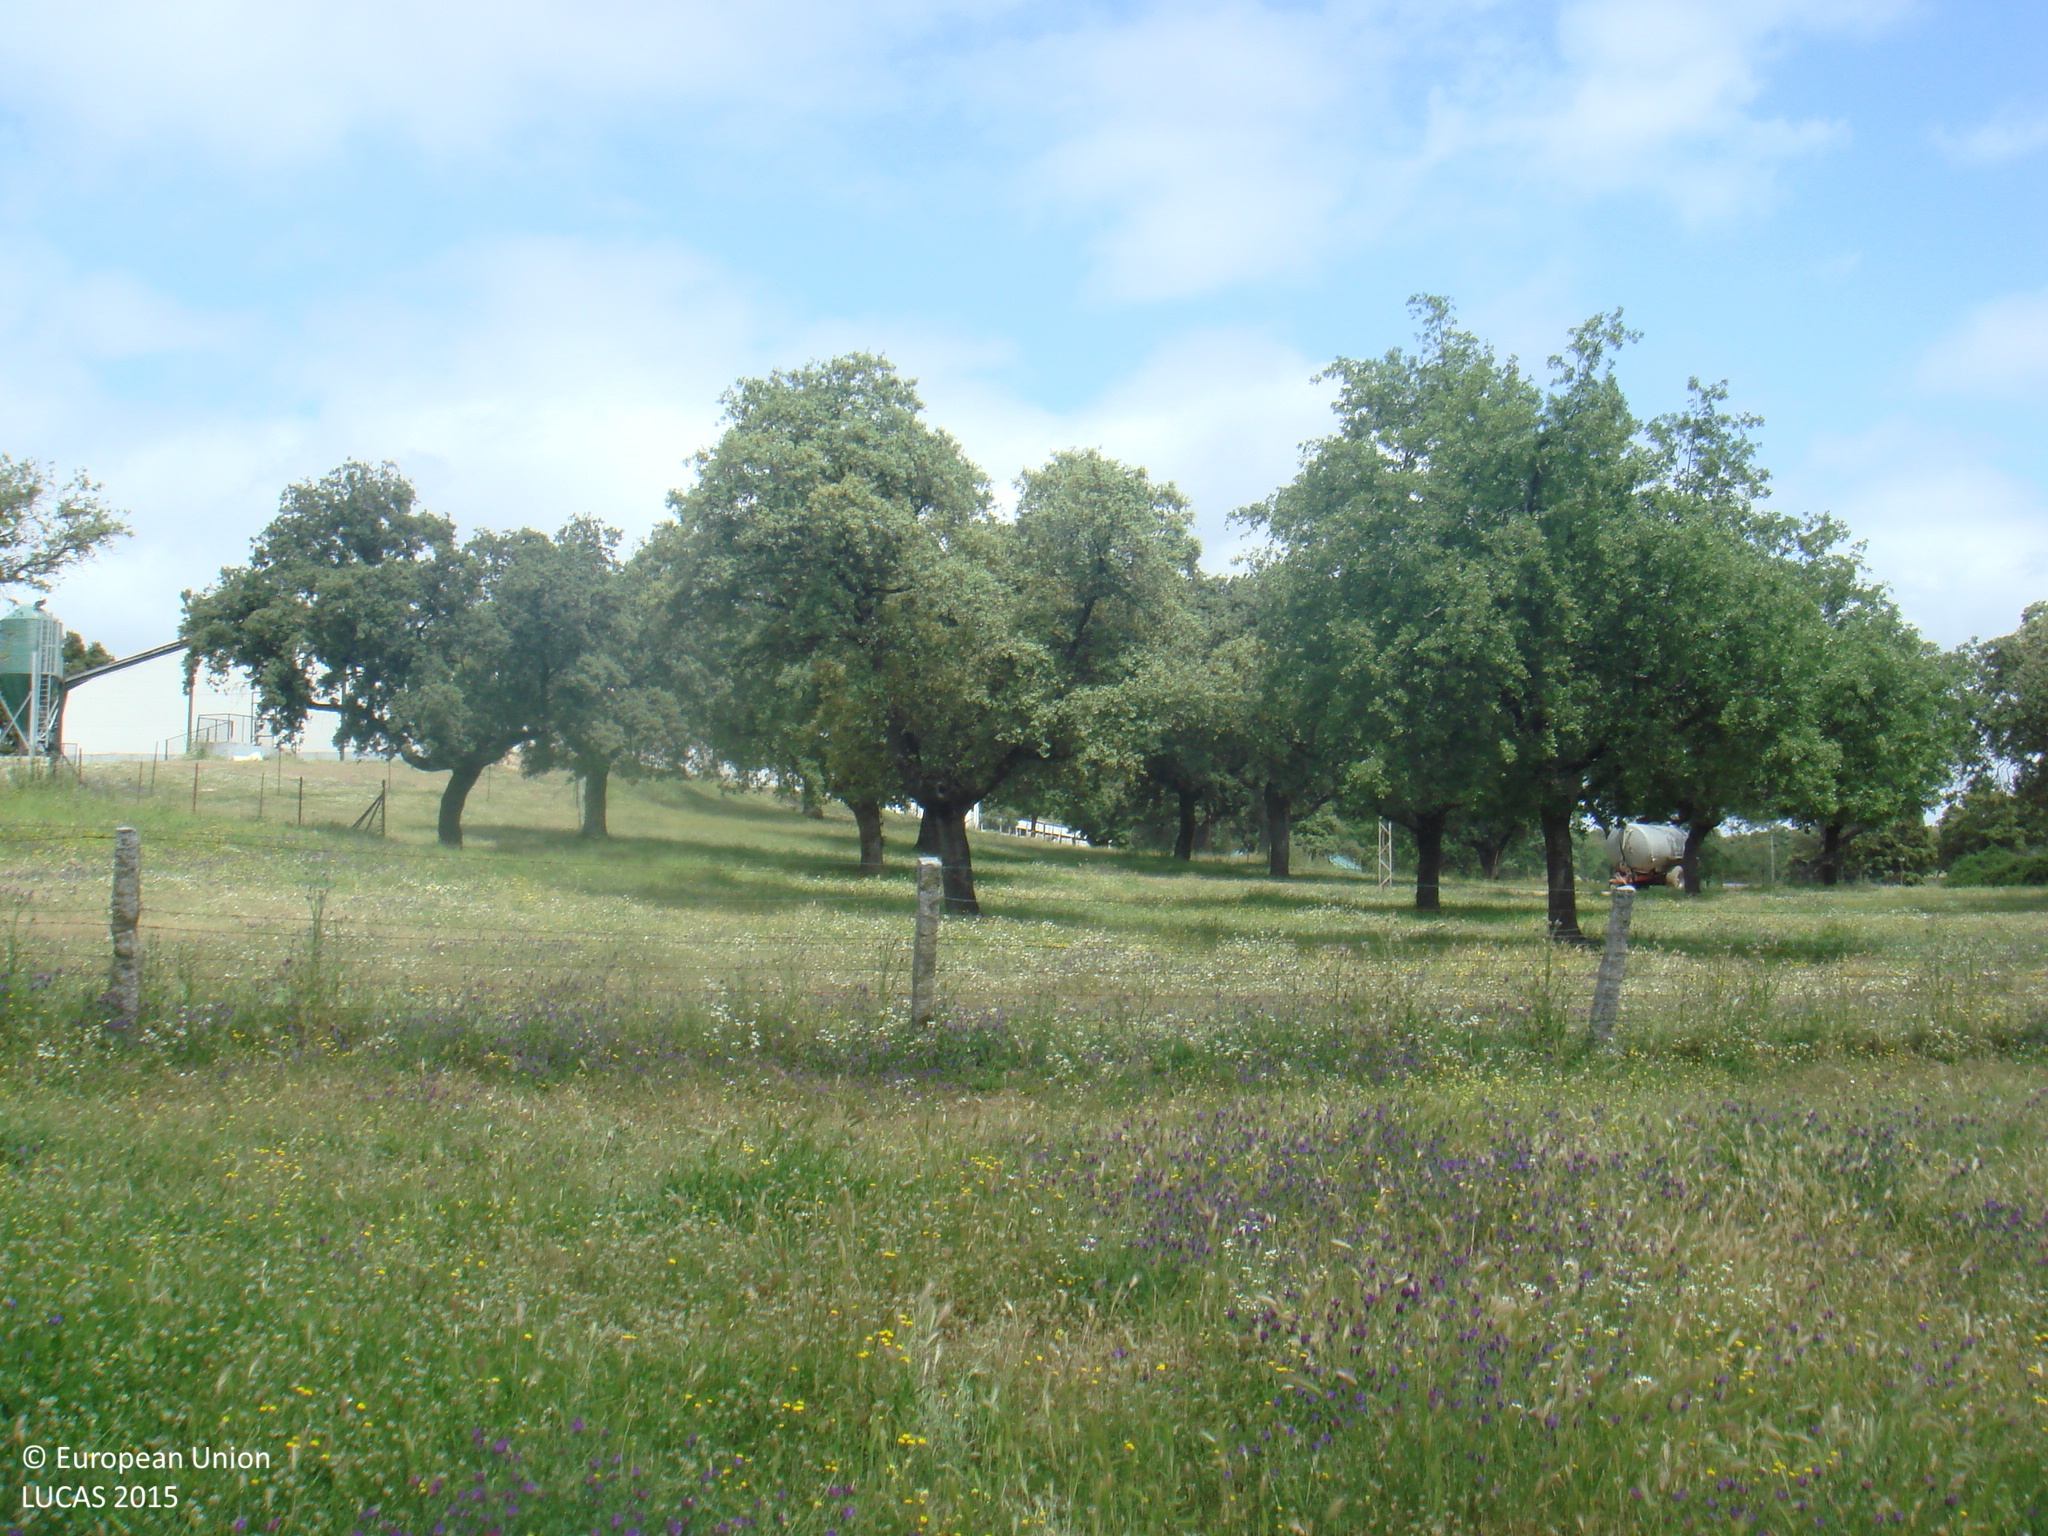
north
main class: Woodland
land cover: Broadleaved woodland
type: broadleaved evergreen forest
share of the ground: 10 - 25 %
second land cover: Spontaneously vegetated surfaces
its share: > 75 %
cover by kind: herbaceous plants 80 %, broadleaved forest trees 20 %
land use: Forestry
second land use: Agriculture (excluding fallow land and kitchen gardens)
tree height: > 5 m
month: May
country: ES
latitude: 38.2899
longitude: -4.3410
